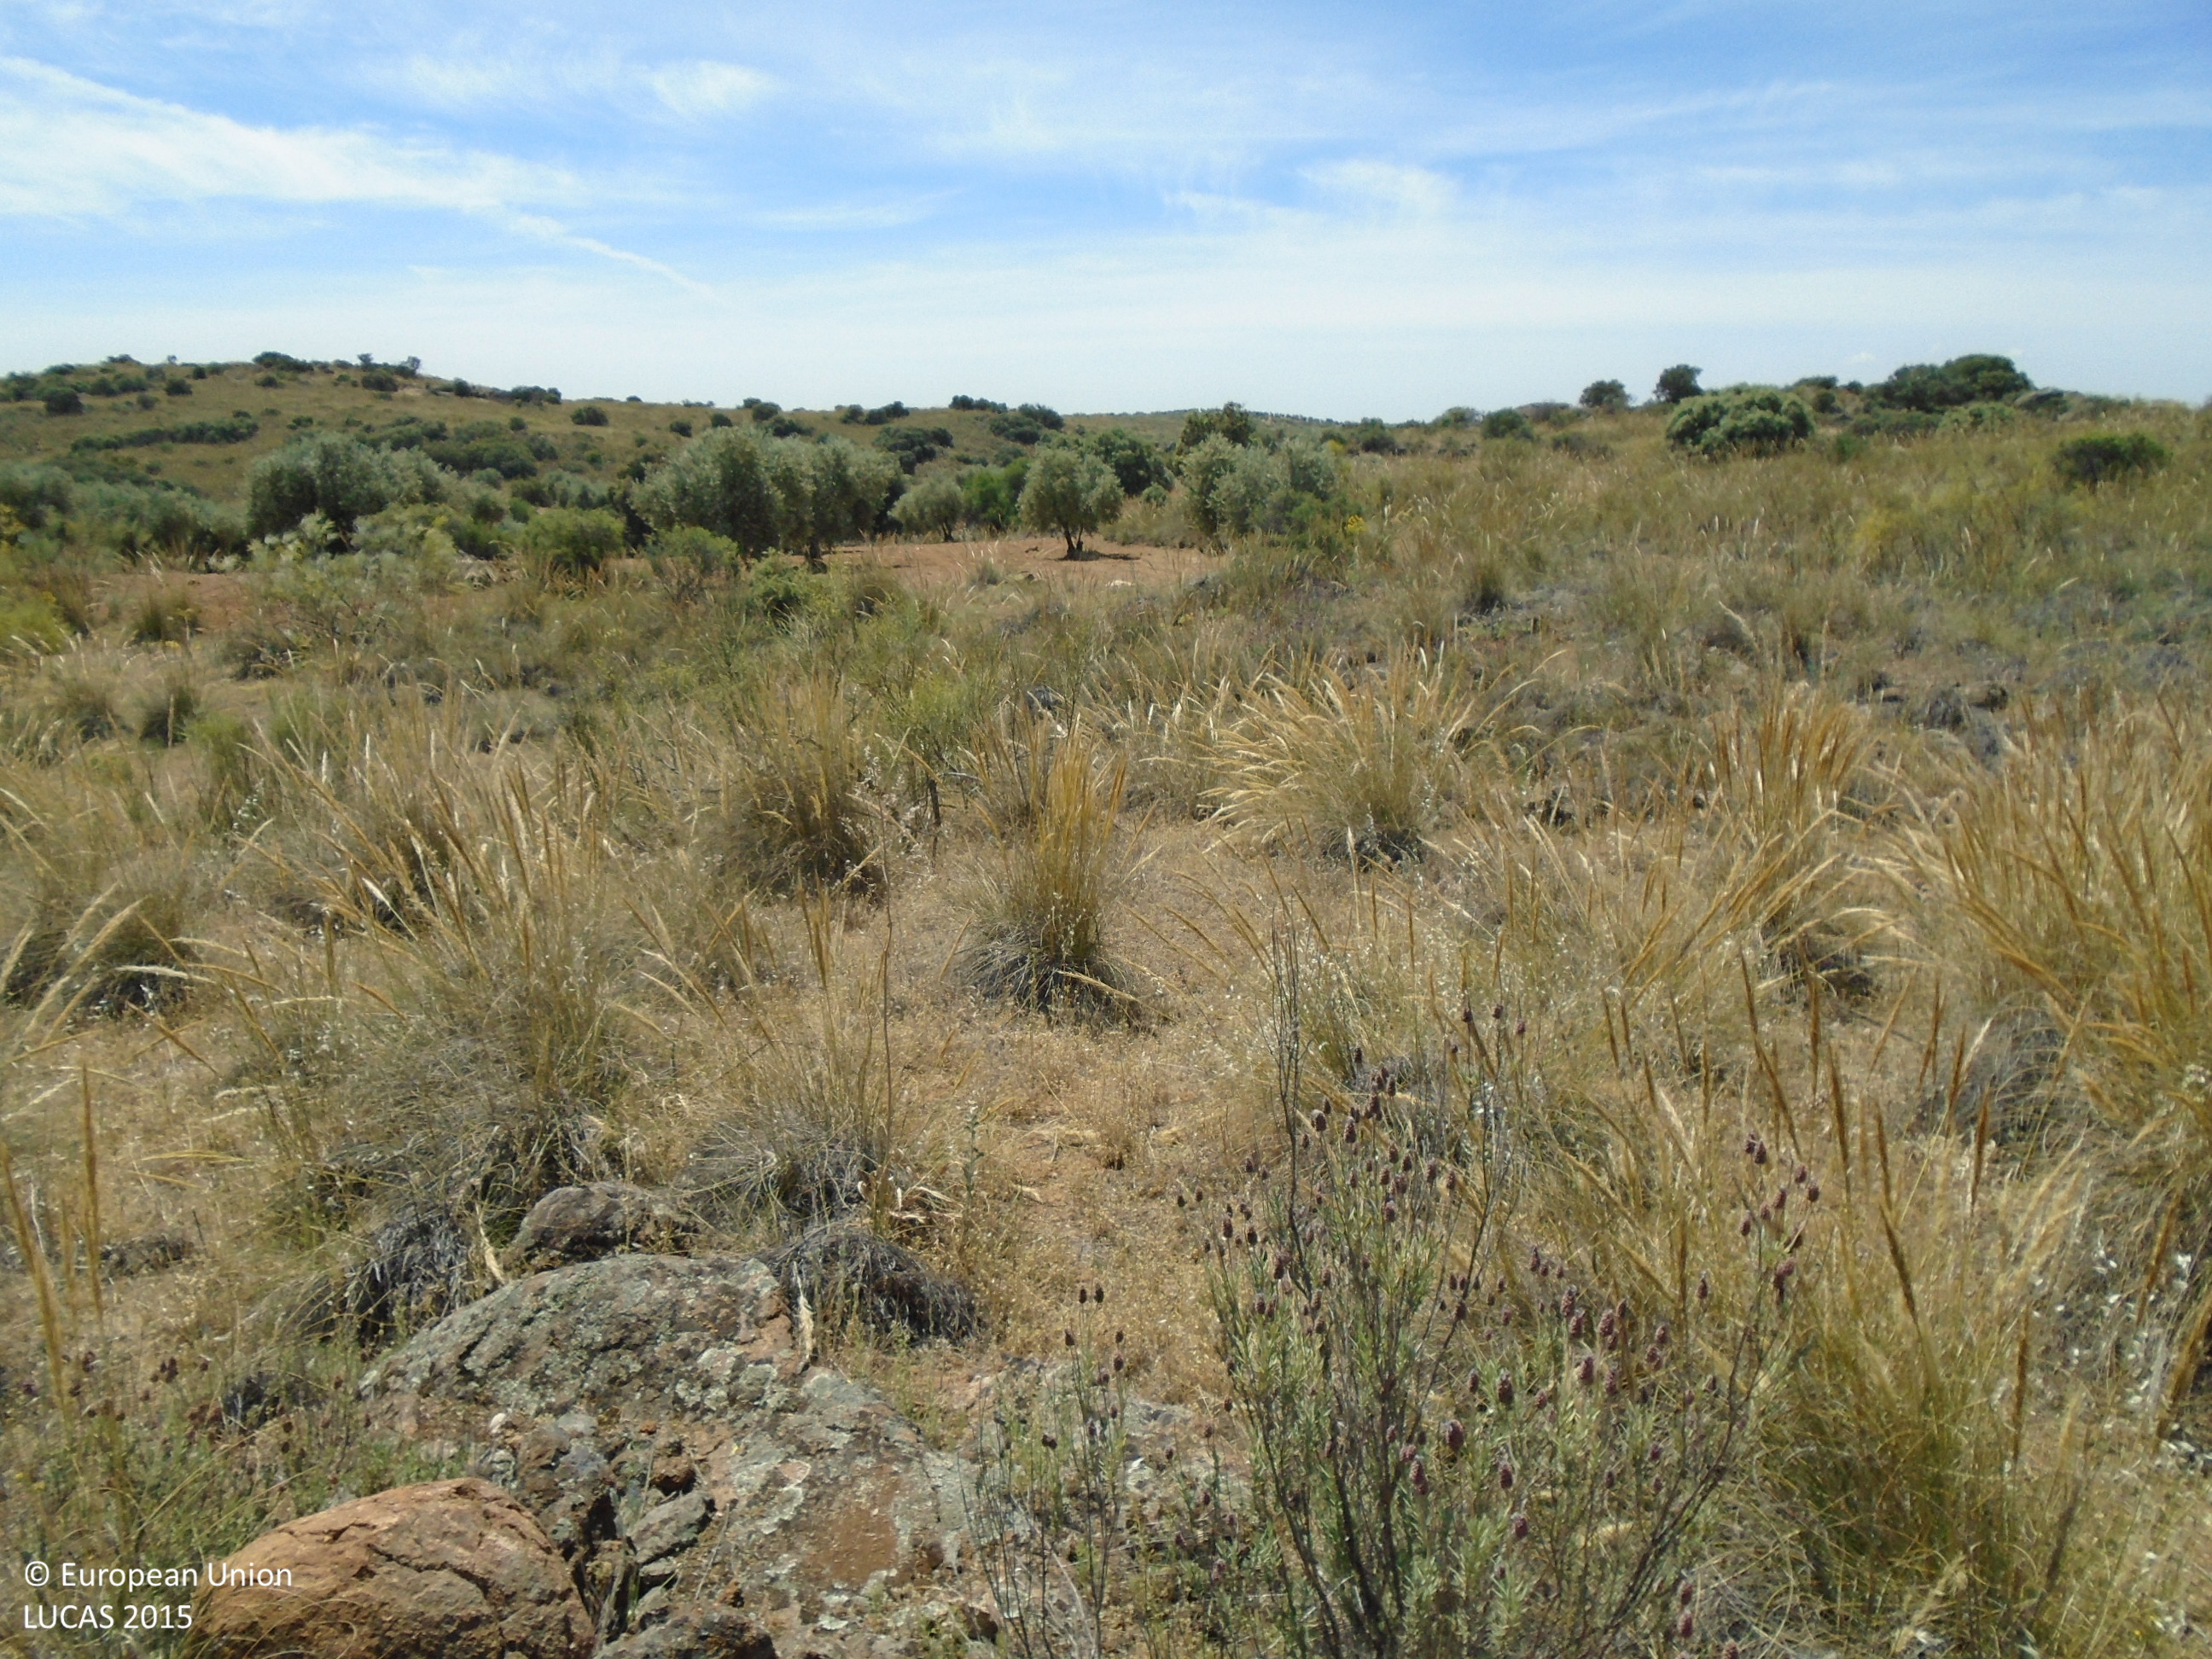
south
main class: Shrubland
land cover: Shrubland without tree cover
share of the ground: > 75 %
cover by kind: herbaceous plants 50 %, shrubs 40 %, consolidated bare surface 10 %
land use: Semi-natural and natural areas not in use
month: May
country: ES
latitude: 39.8033
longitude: -3.7775
